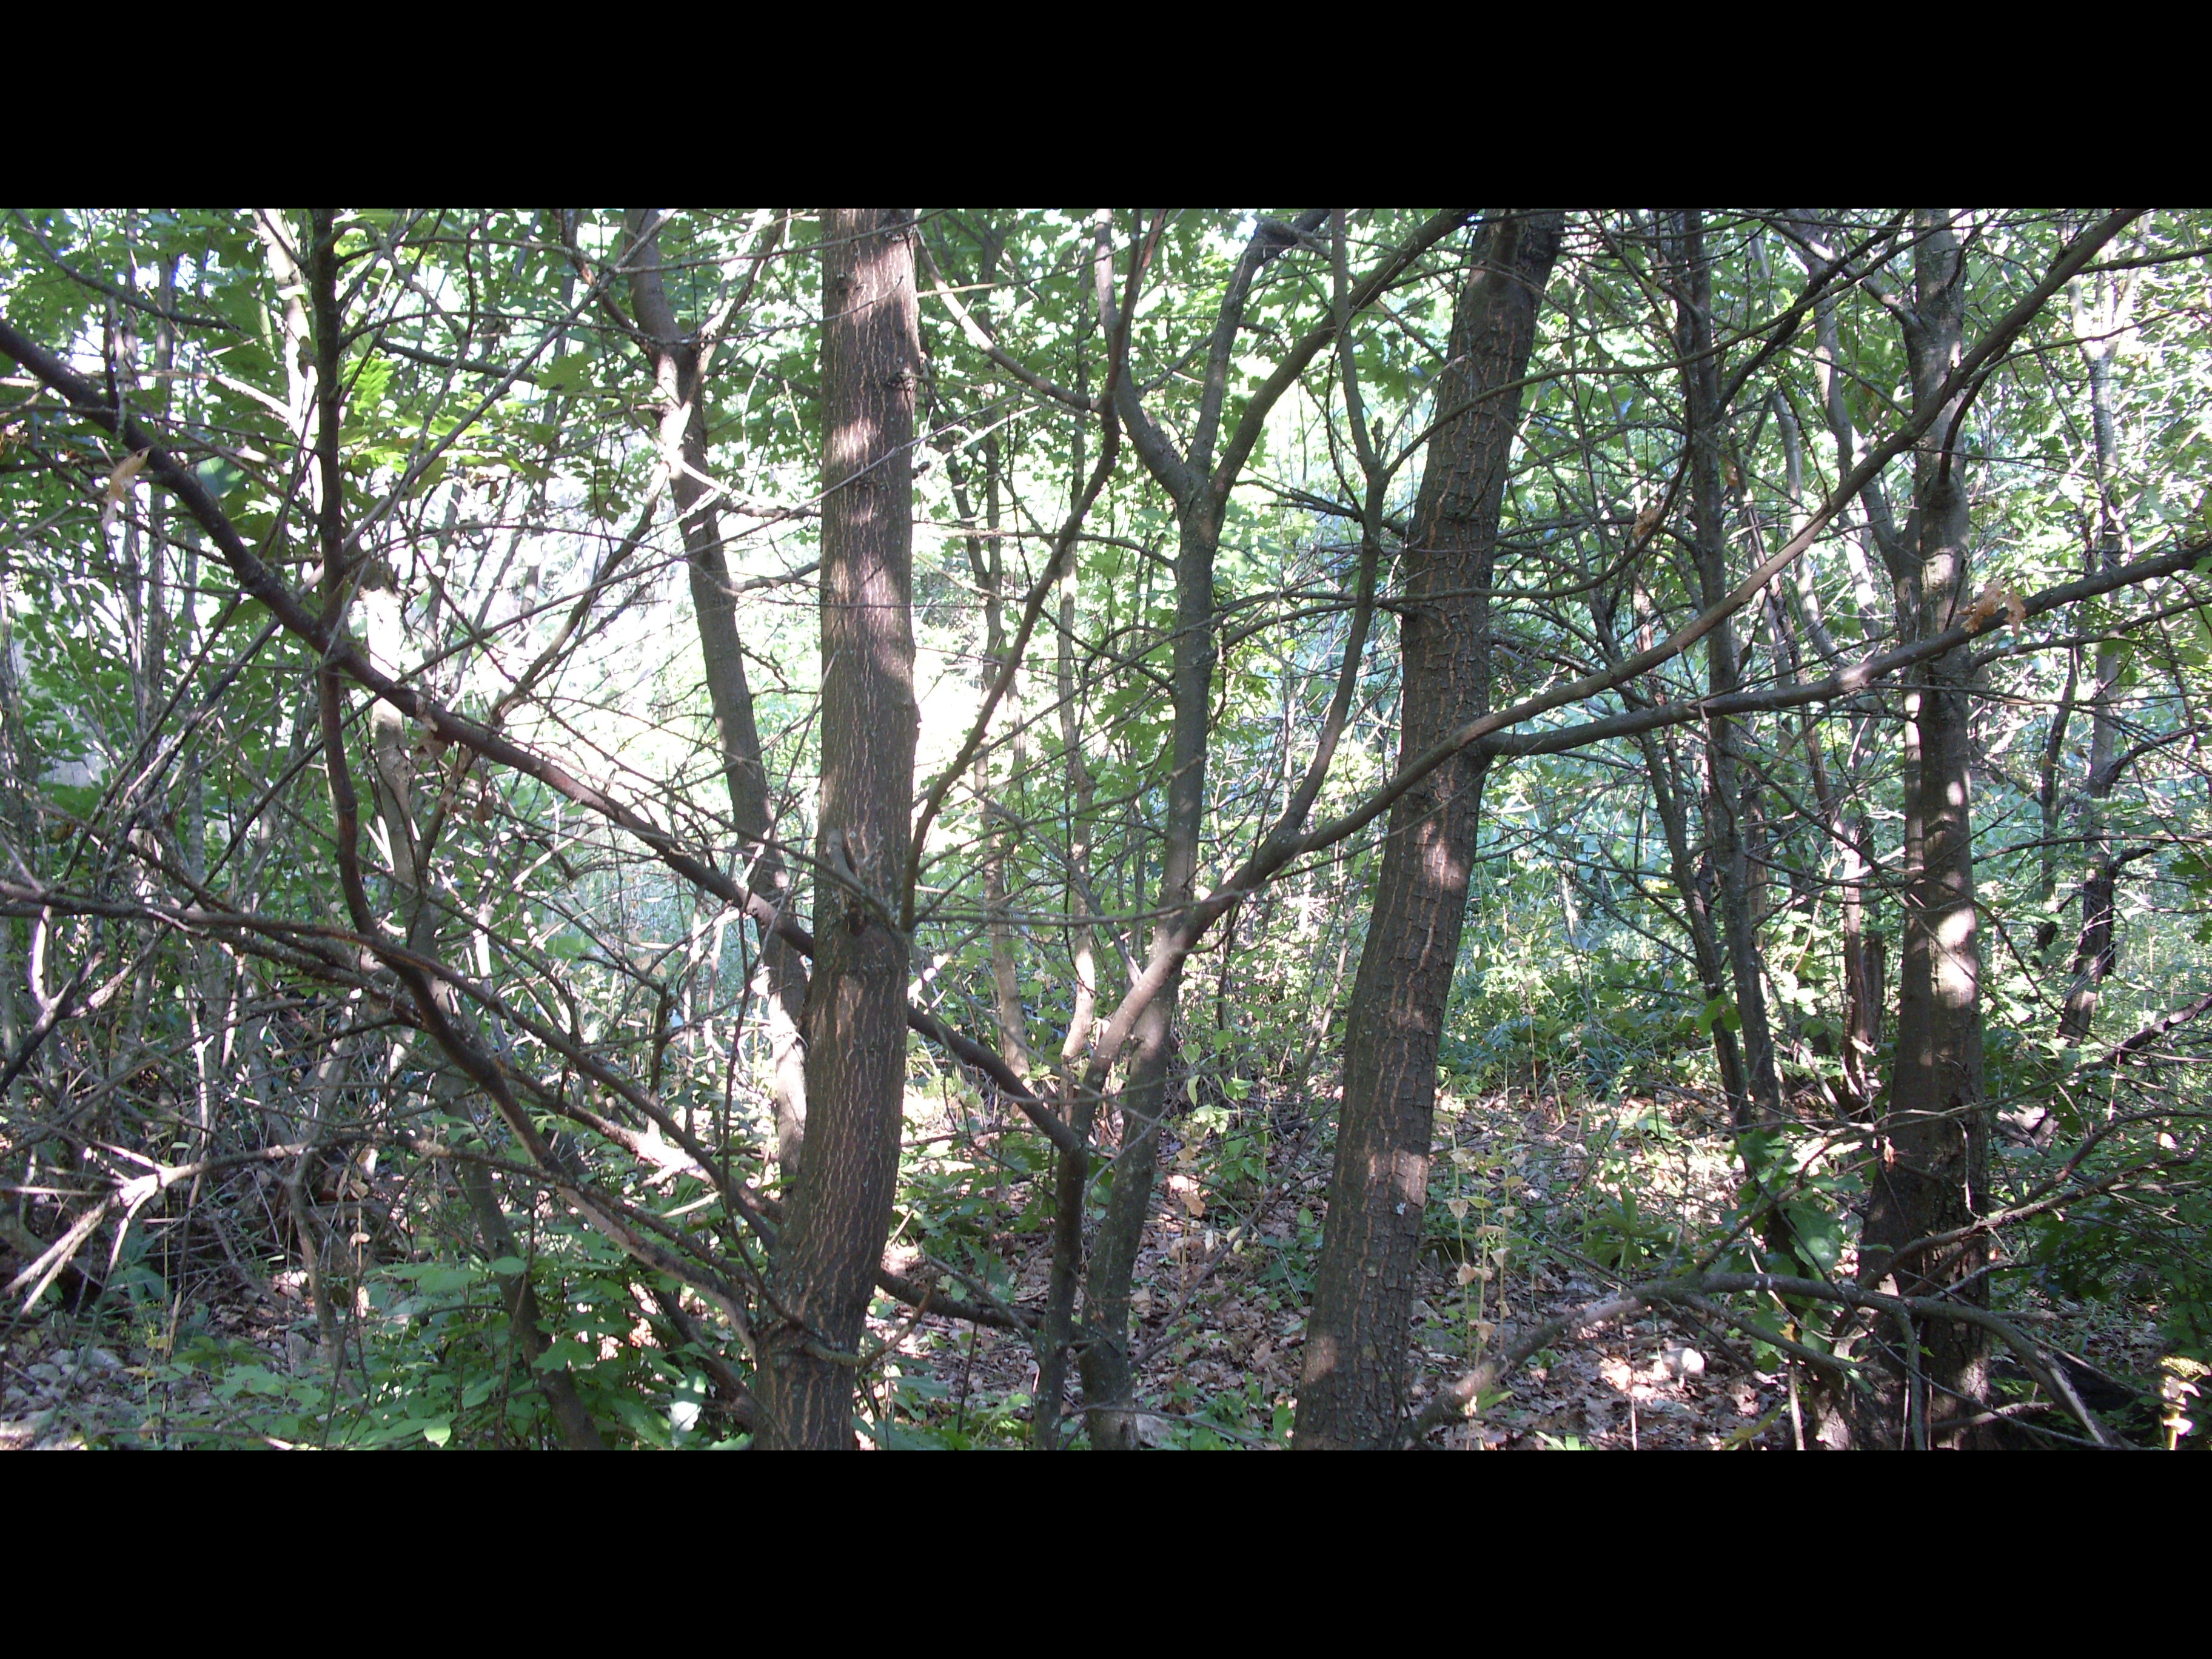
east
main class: Woodland
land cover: Broadleaved woodland
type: mesophytic deciduous forest
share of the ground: > 75 %
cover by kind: broadleaved forest trees 95 %, shrubs 5 %
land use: Forestry
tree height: > 5 m
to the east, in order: Broadleaved woodland; Grassland with sparse tree/shrub cover; Shrubland with sparse tree cover; Grassland with sparse tree/shrub cover; Shrubland with sparse tree cover
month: June
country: BG
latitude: 43.4776
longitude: 23.5329
